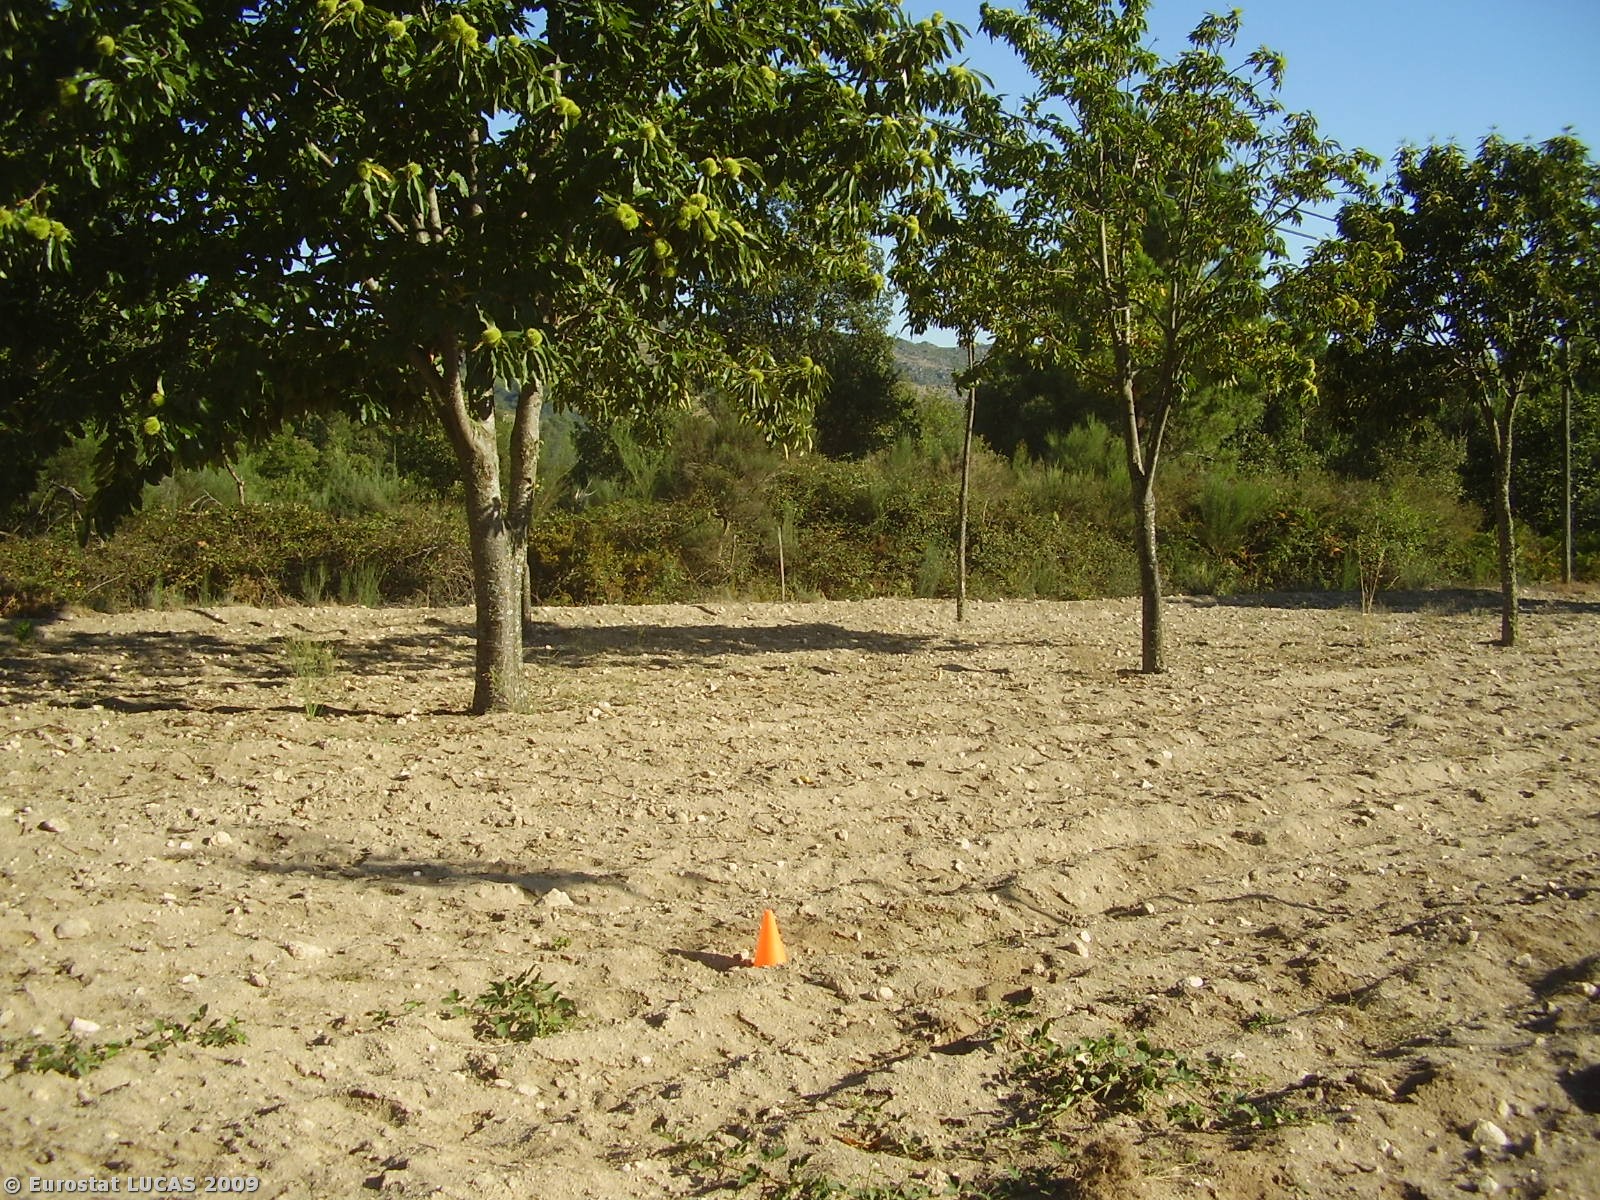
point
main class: Cropland
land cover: Other fruit trees and berries
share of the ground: 10 - 25 %
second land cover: Spontaneously vegetated surfaces
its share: 10 - 25 %
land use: Agriculture (excluding fallow land and kitchen gardens)
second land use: Fallow land
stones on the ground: 25 - 50 %
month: September
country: PT
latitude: 41.7213
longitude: -7.6237
